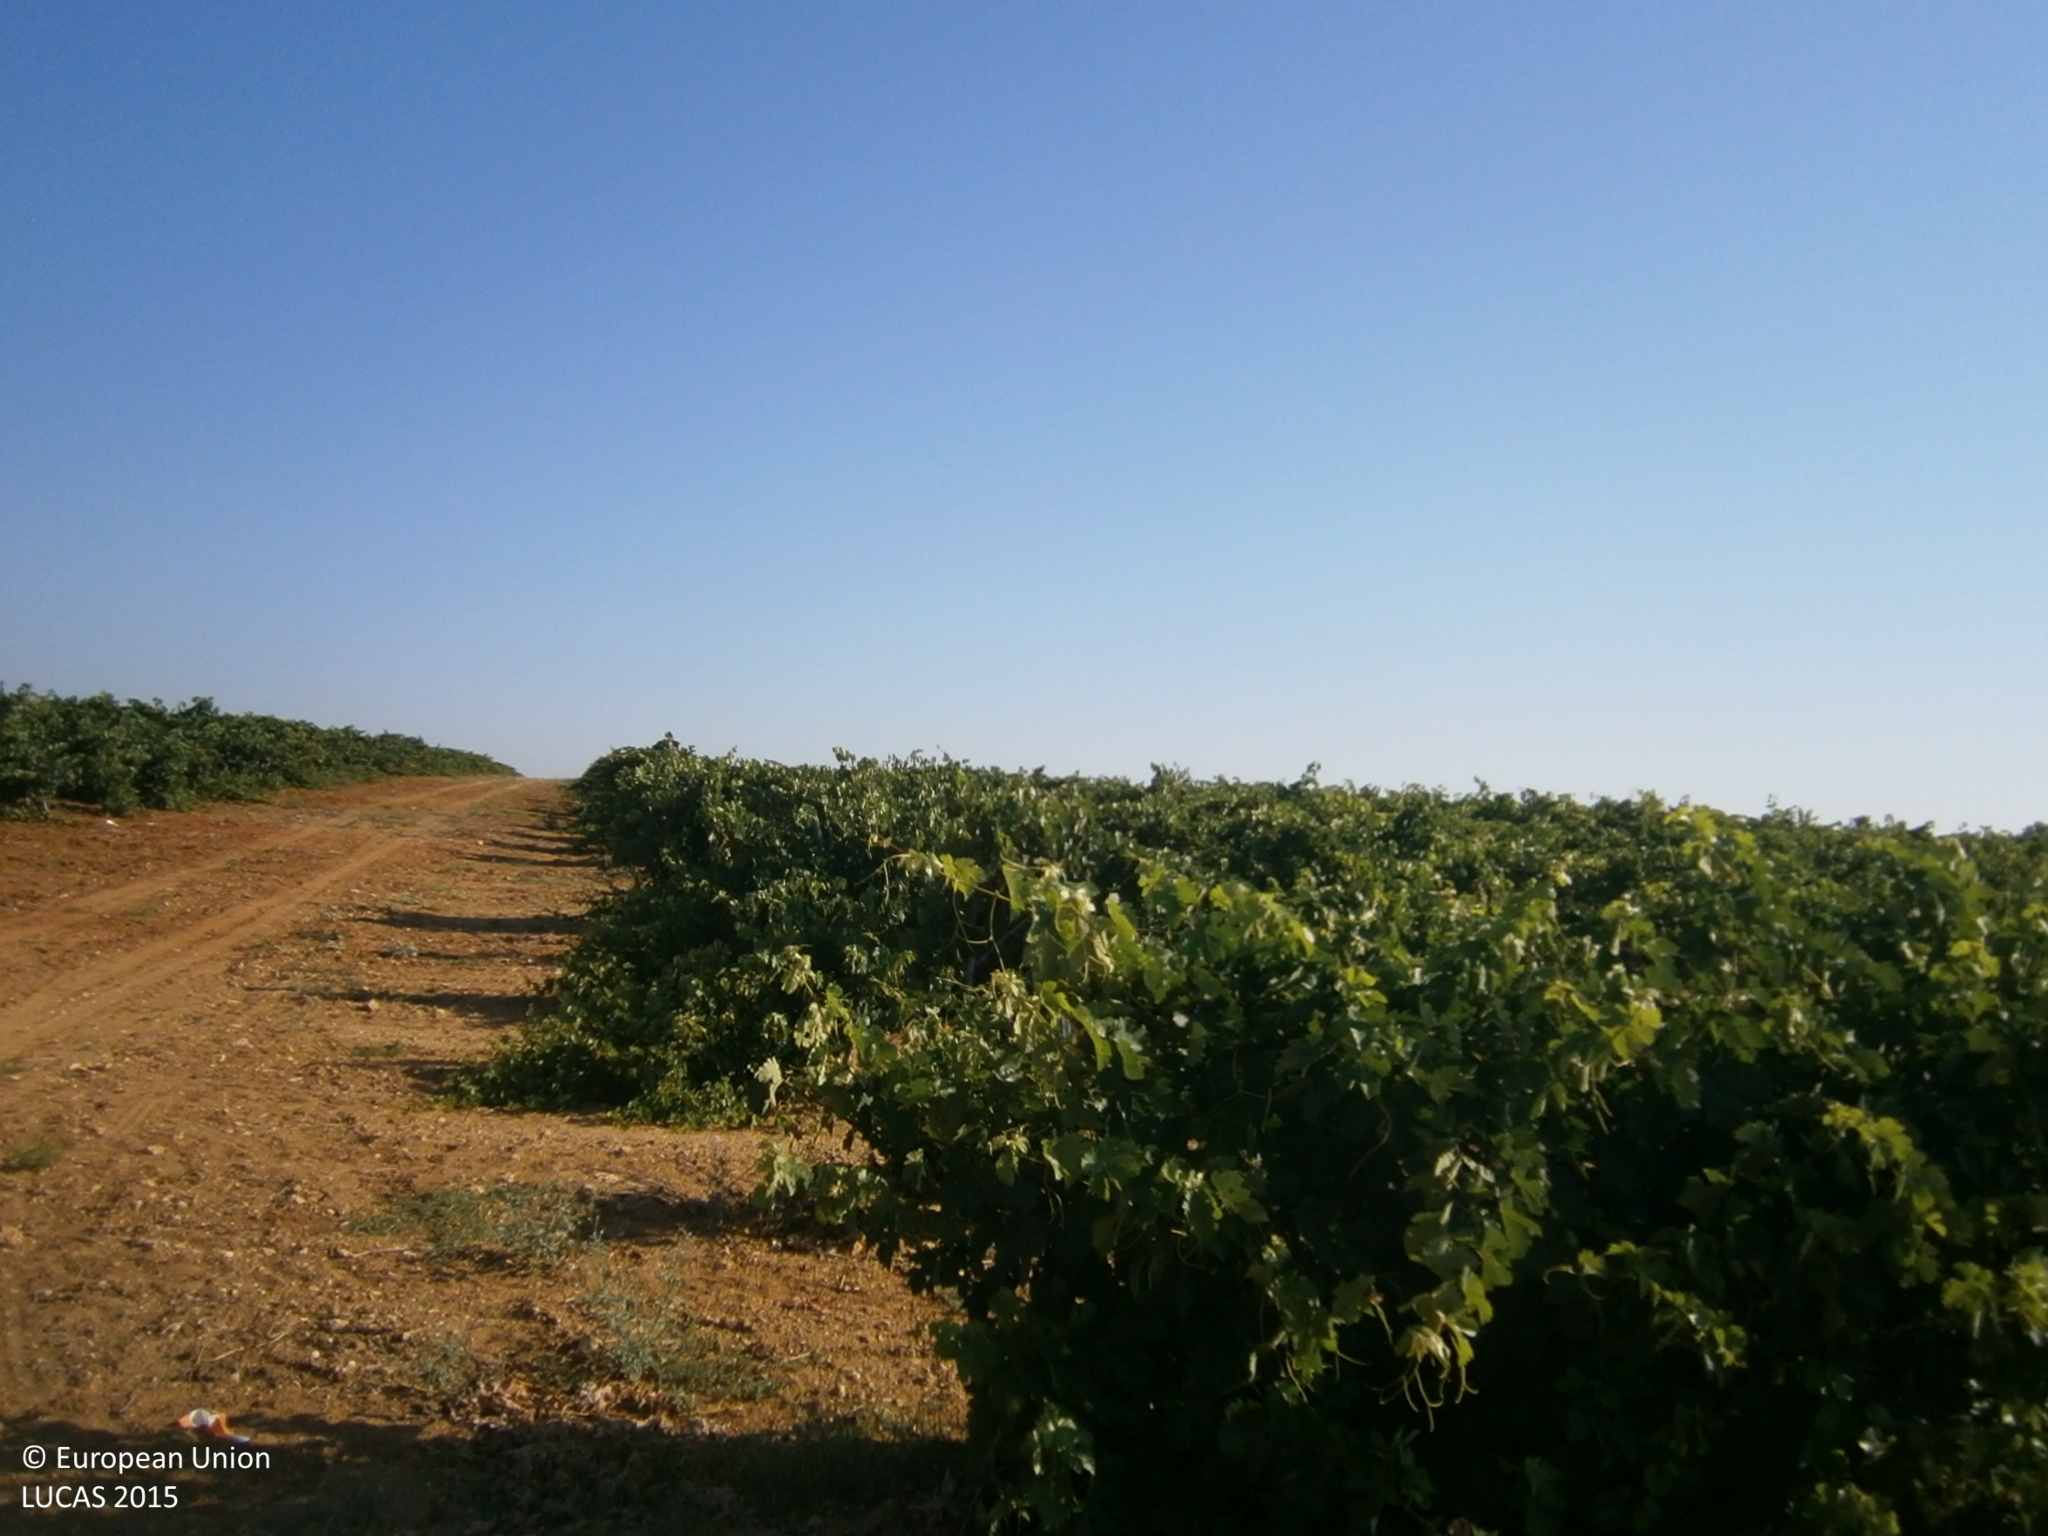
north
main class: Cropland
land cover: Barley
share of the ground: > 75 %
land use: Agriculture (excluding fallow land and kitchen gardens)
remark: Harvested field
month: June
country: ES
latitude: 38.7585
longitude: -6.7609
